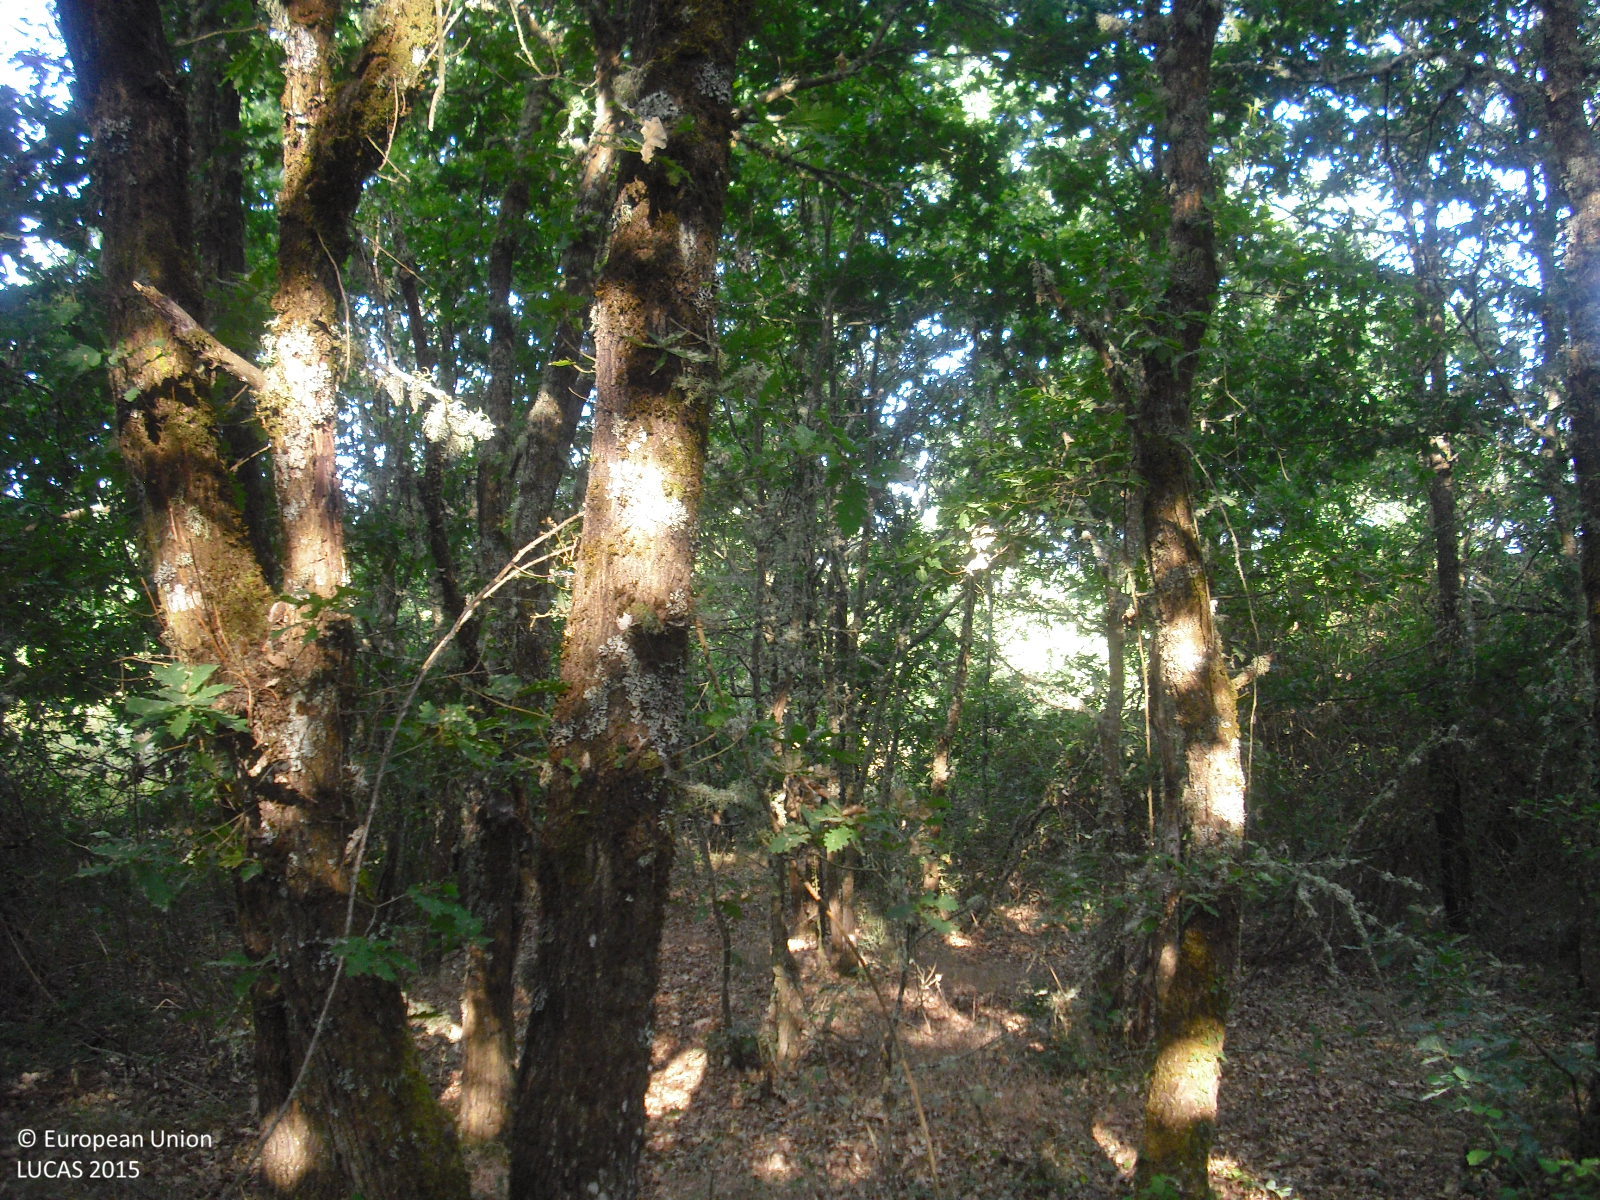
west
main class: Woodland
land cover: Broadleaved woodland
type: thermophilous deciduous forest
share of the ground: > 75 %
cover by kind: broadleaved forest trees 80 %, shrubs 20 %
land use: Semi-natural and natural areas not in use
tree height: > 5 m
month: July
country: ES
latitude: 42.5763
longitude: -7.4796
